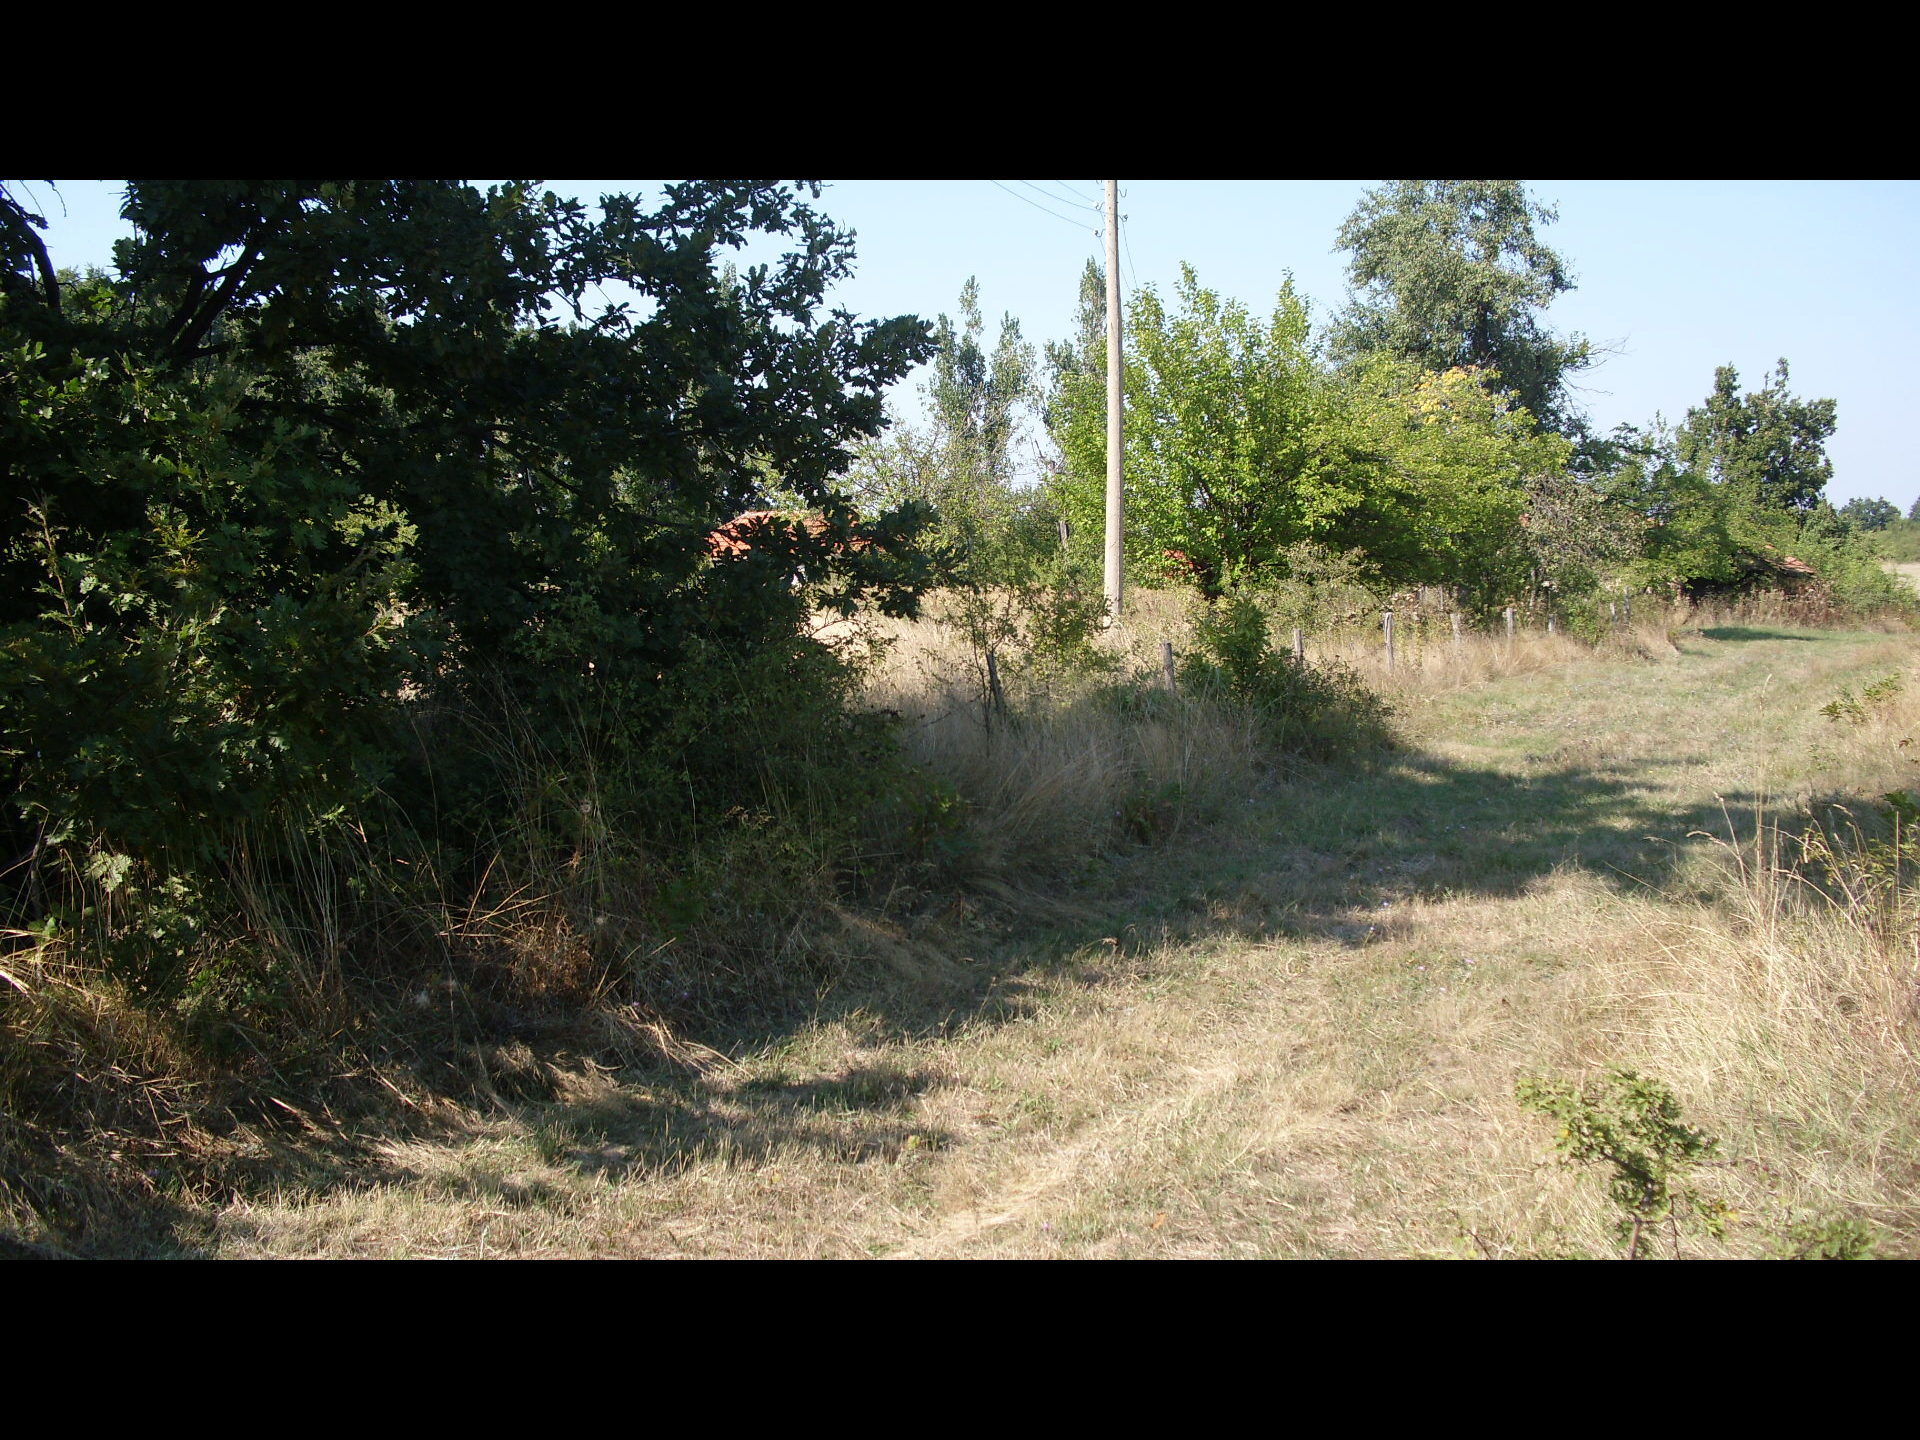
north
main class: Grassland
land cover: Grassland with sparse tree/shrub cover
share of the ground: > 75 %
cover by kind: herbaceous plants 90 %, broadleaved forest trees 5 %, shrubs 5 %
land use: Semi-natural and natural areas not in use
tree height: < 5 m
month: September
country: BG
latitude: 44.0026
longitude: 22.4175
